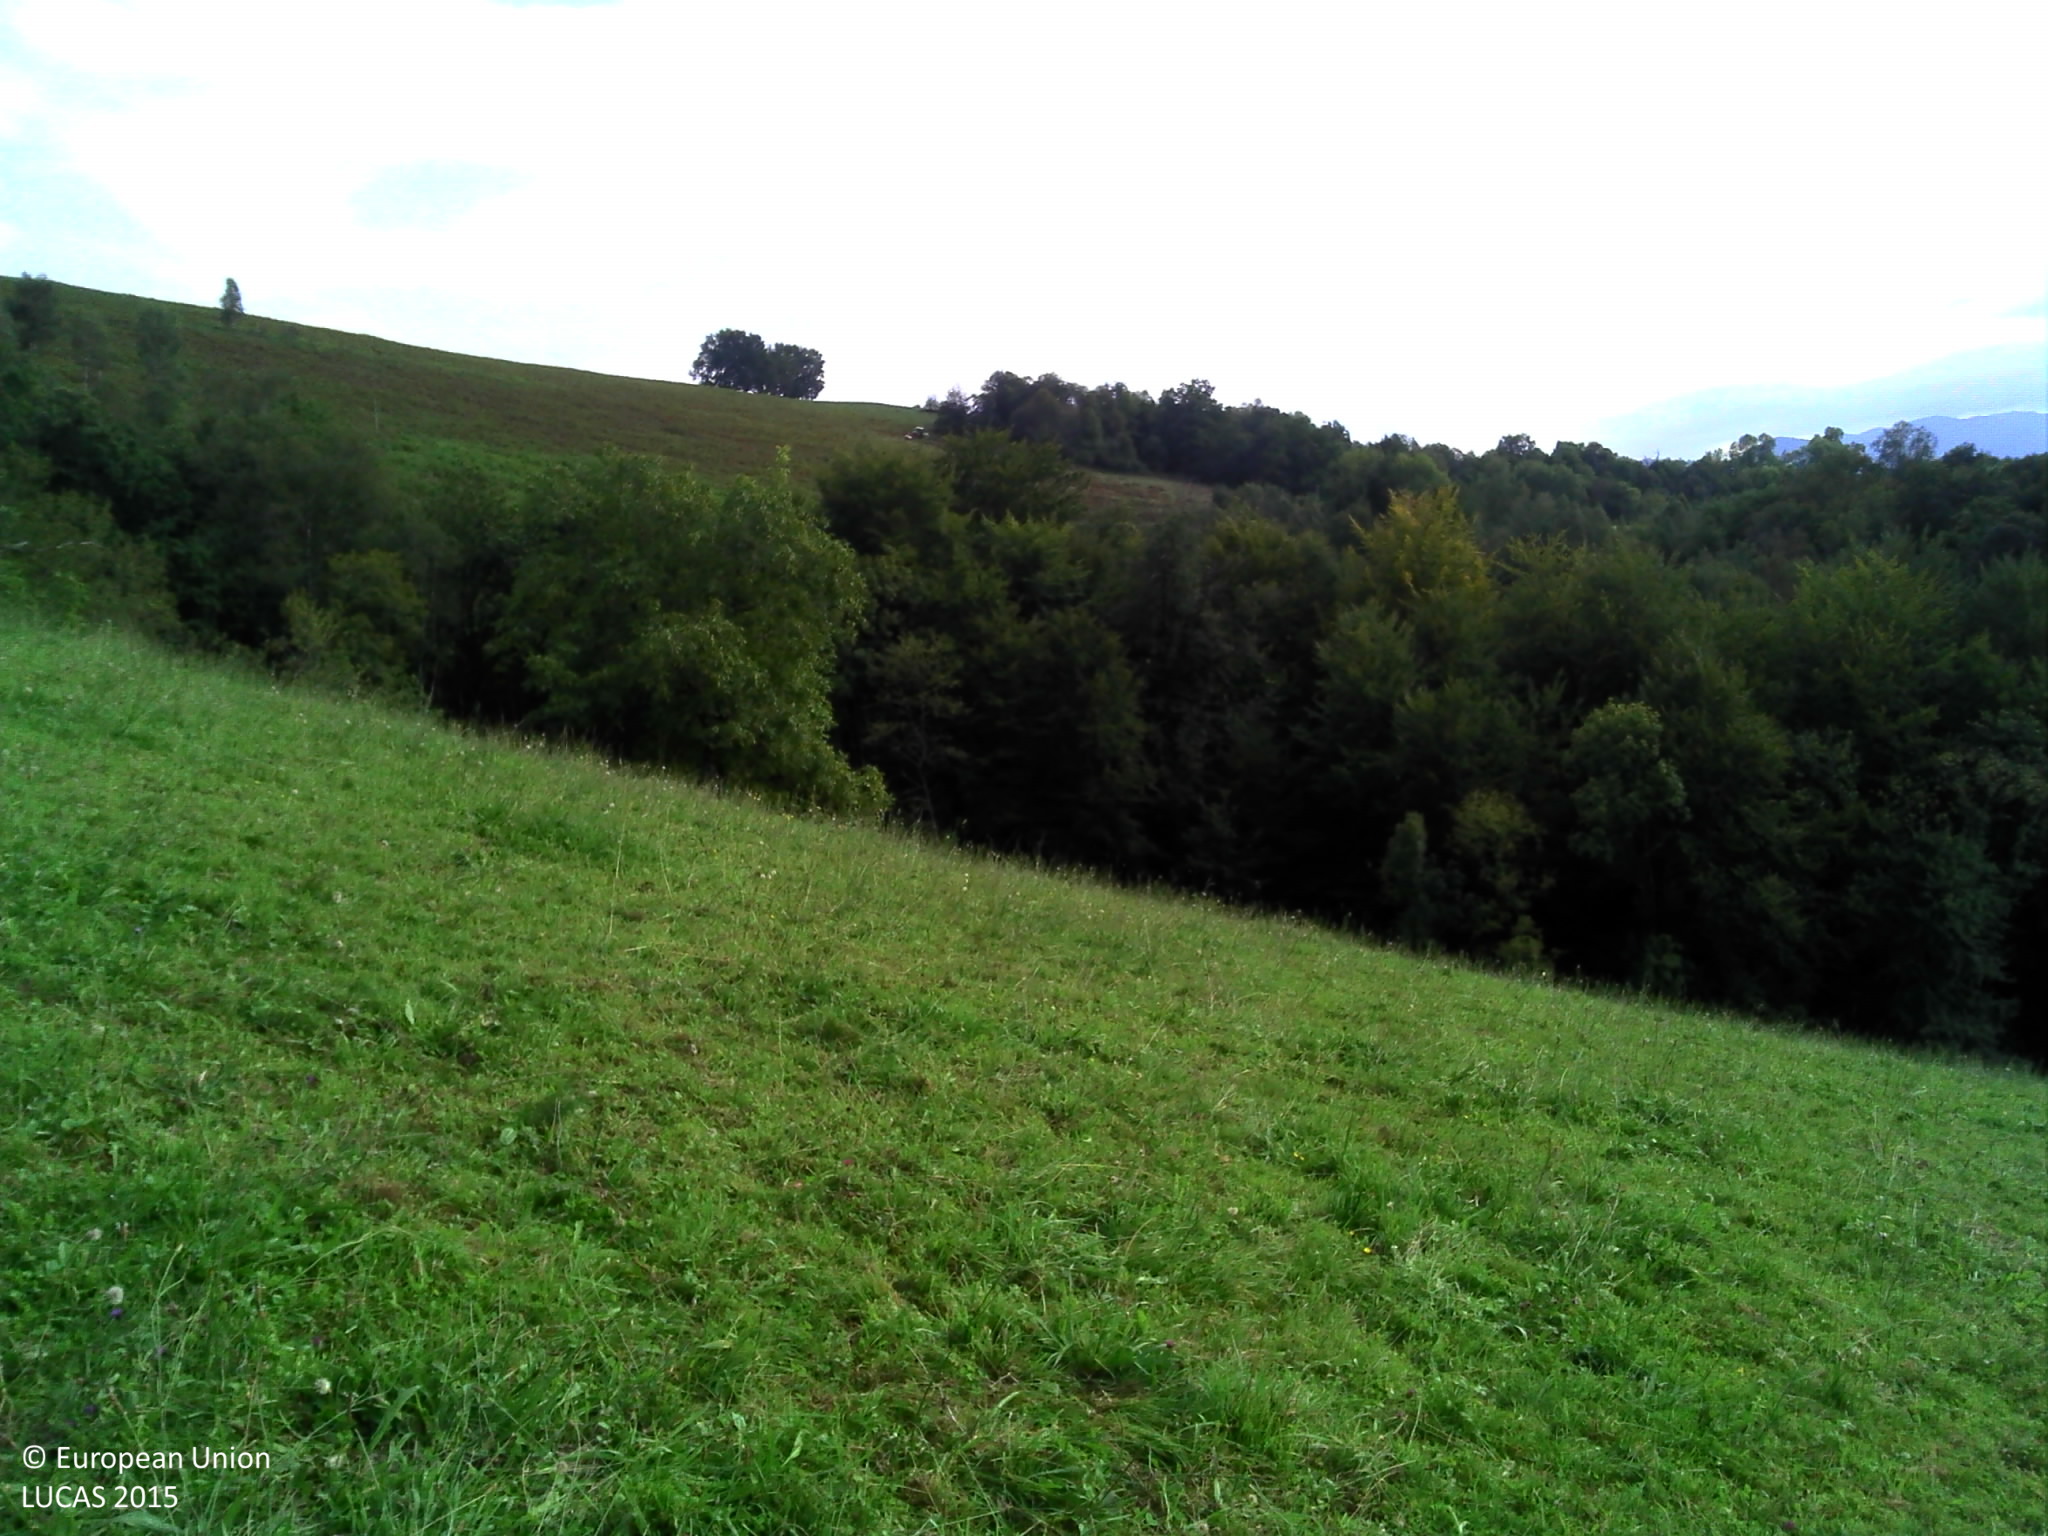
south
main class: Grassland
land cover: Grassland without tree/shrub cover
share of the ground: > 75 %
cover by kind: herbaceous plants 100 %
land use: Agriculture (excluding fallow land and kitchen gardens)
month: September
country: FR
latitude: 43.1214
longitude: -0.7137
